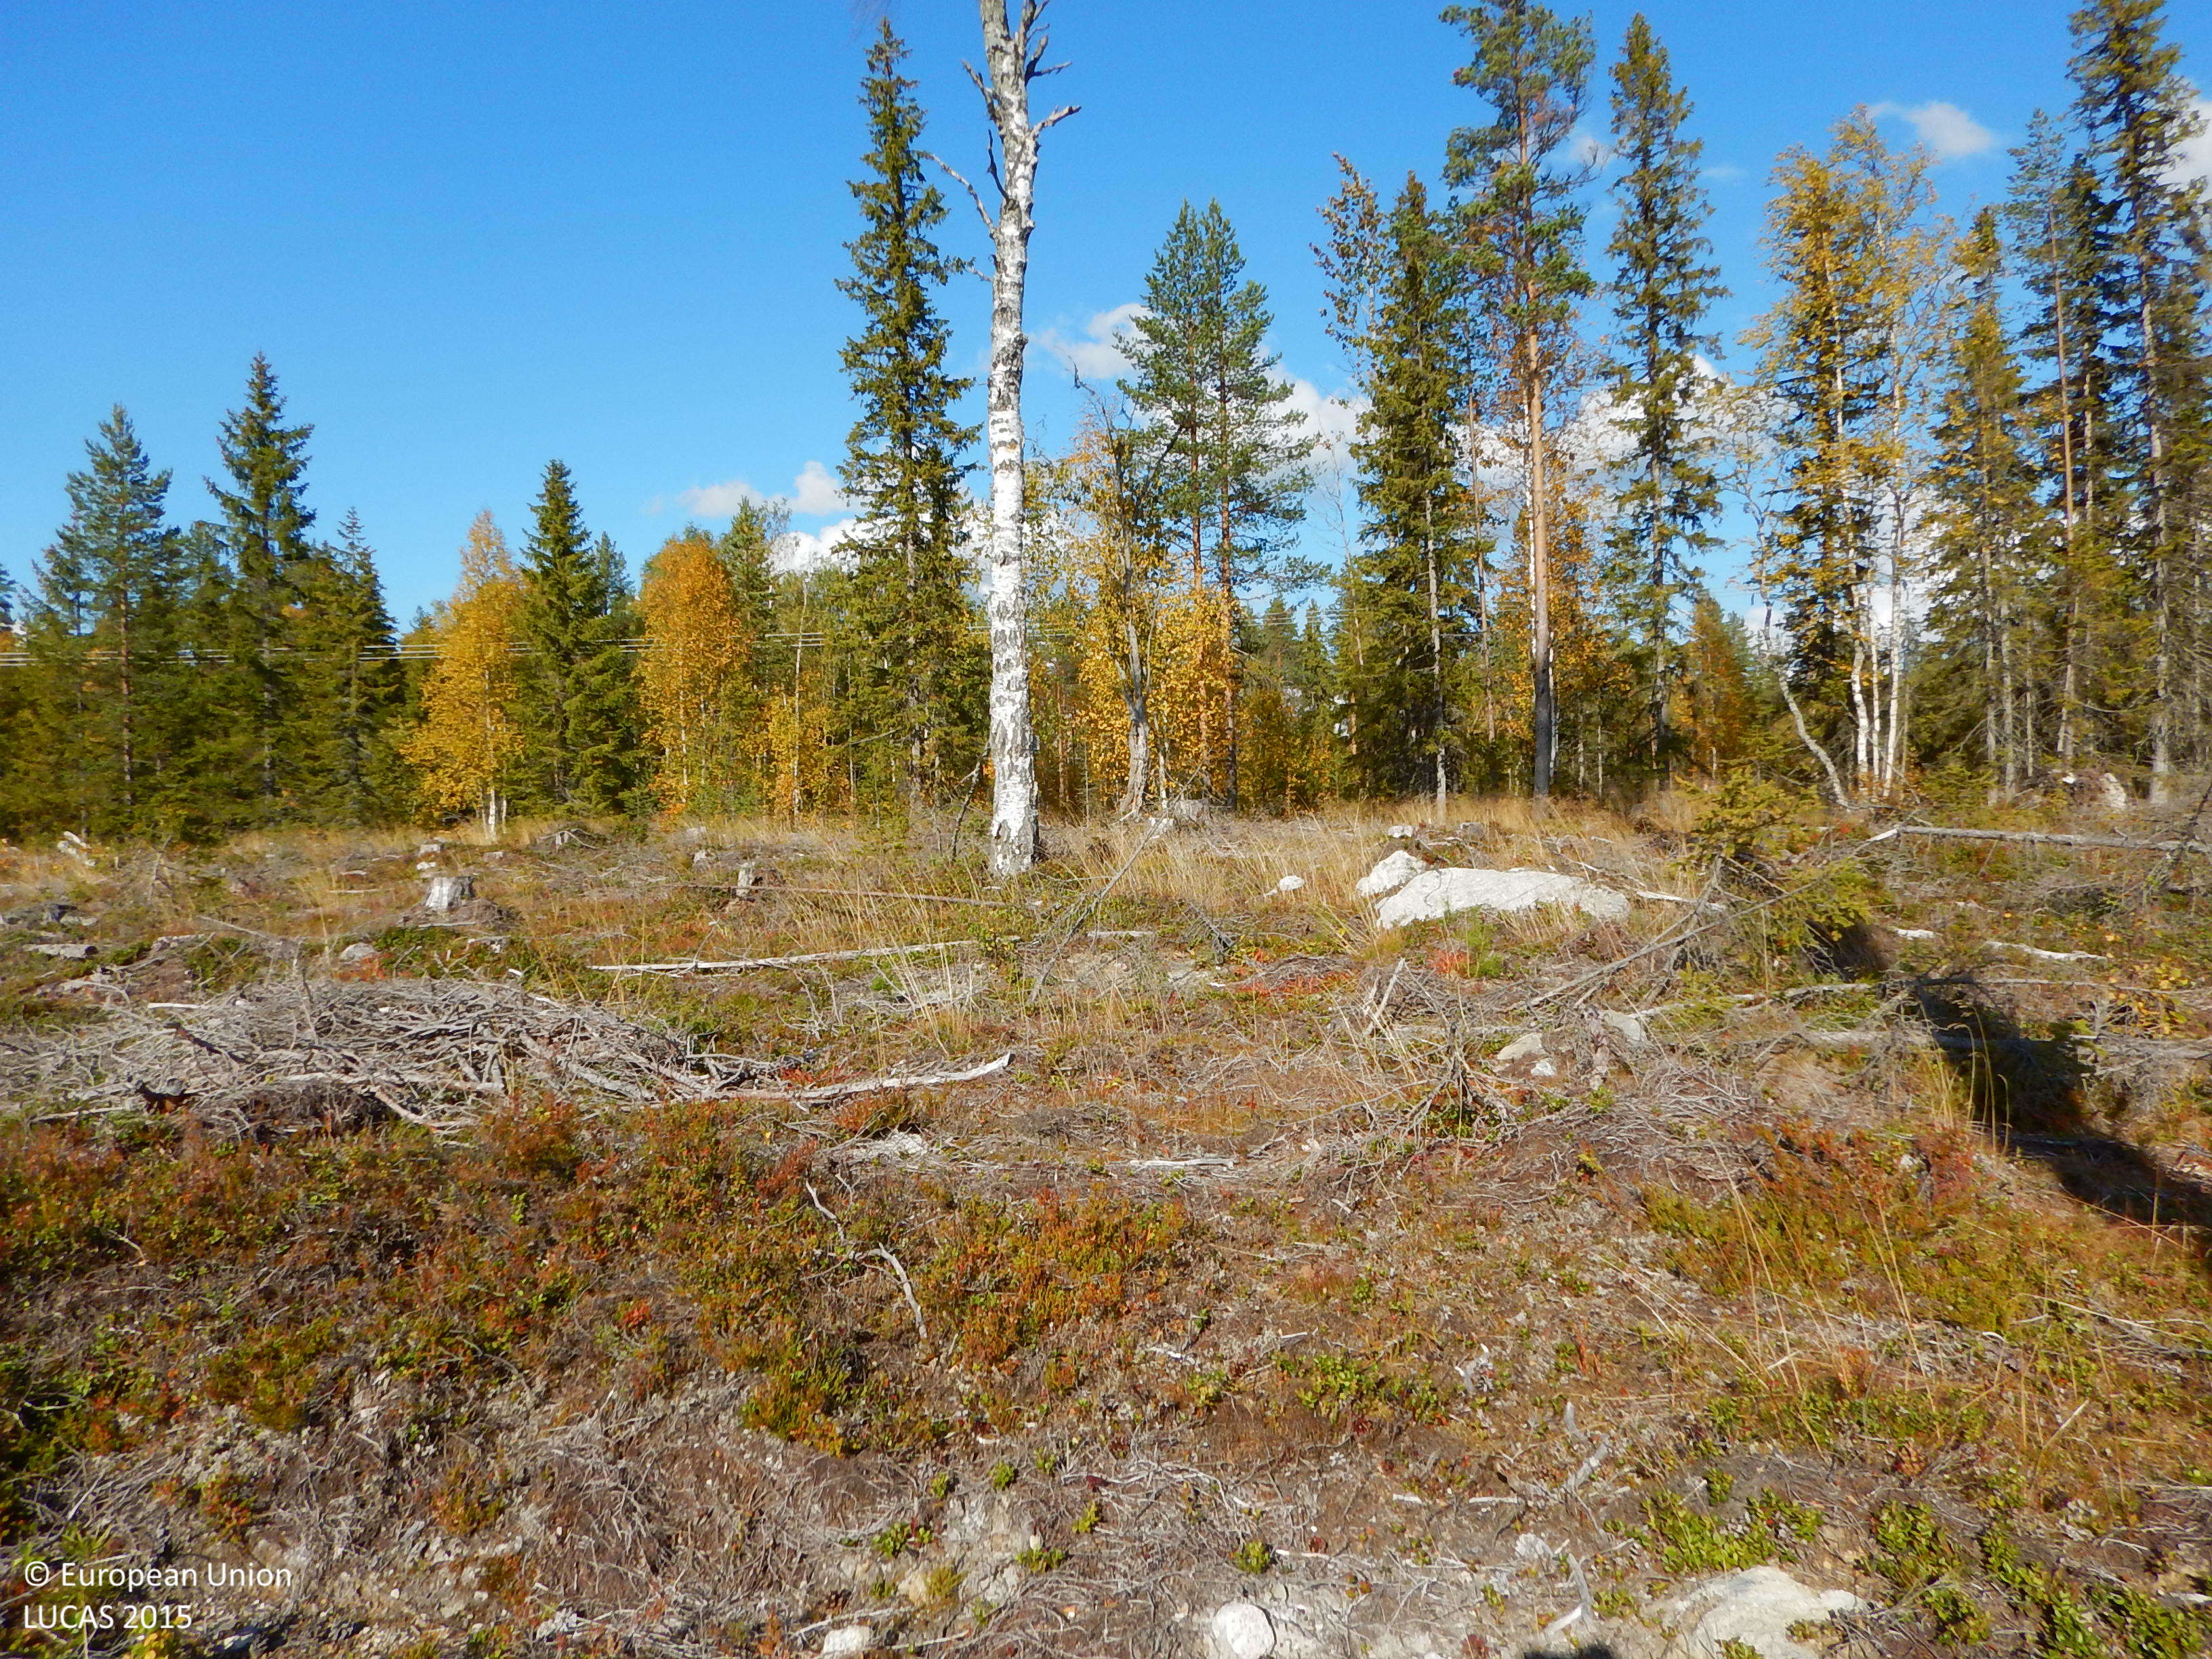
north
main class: Shrubland
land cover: Shrubland with sparse tree cover
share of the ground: 50 - 75 %
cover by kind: shrubs 45 %, unconsolidated bare surface 20 %, herbaceous plants 15 %, lichens and mosses 10 %, coniferous forest trees 5 %, consolidated bare surface 5 %
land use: Forestry
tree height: < 5 m
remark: Clear cut
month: September
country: SE
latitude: 64.7820
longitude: 20.1746
